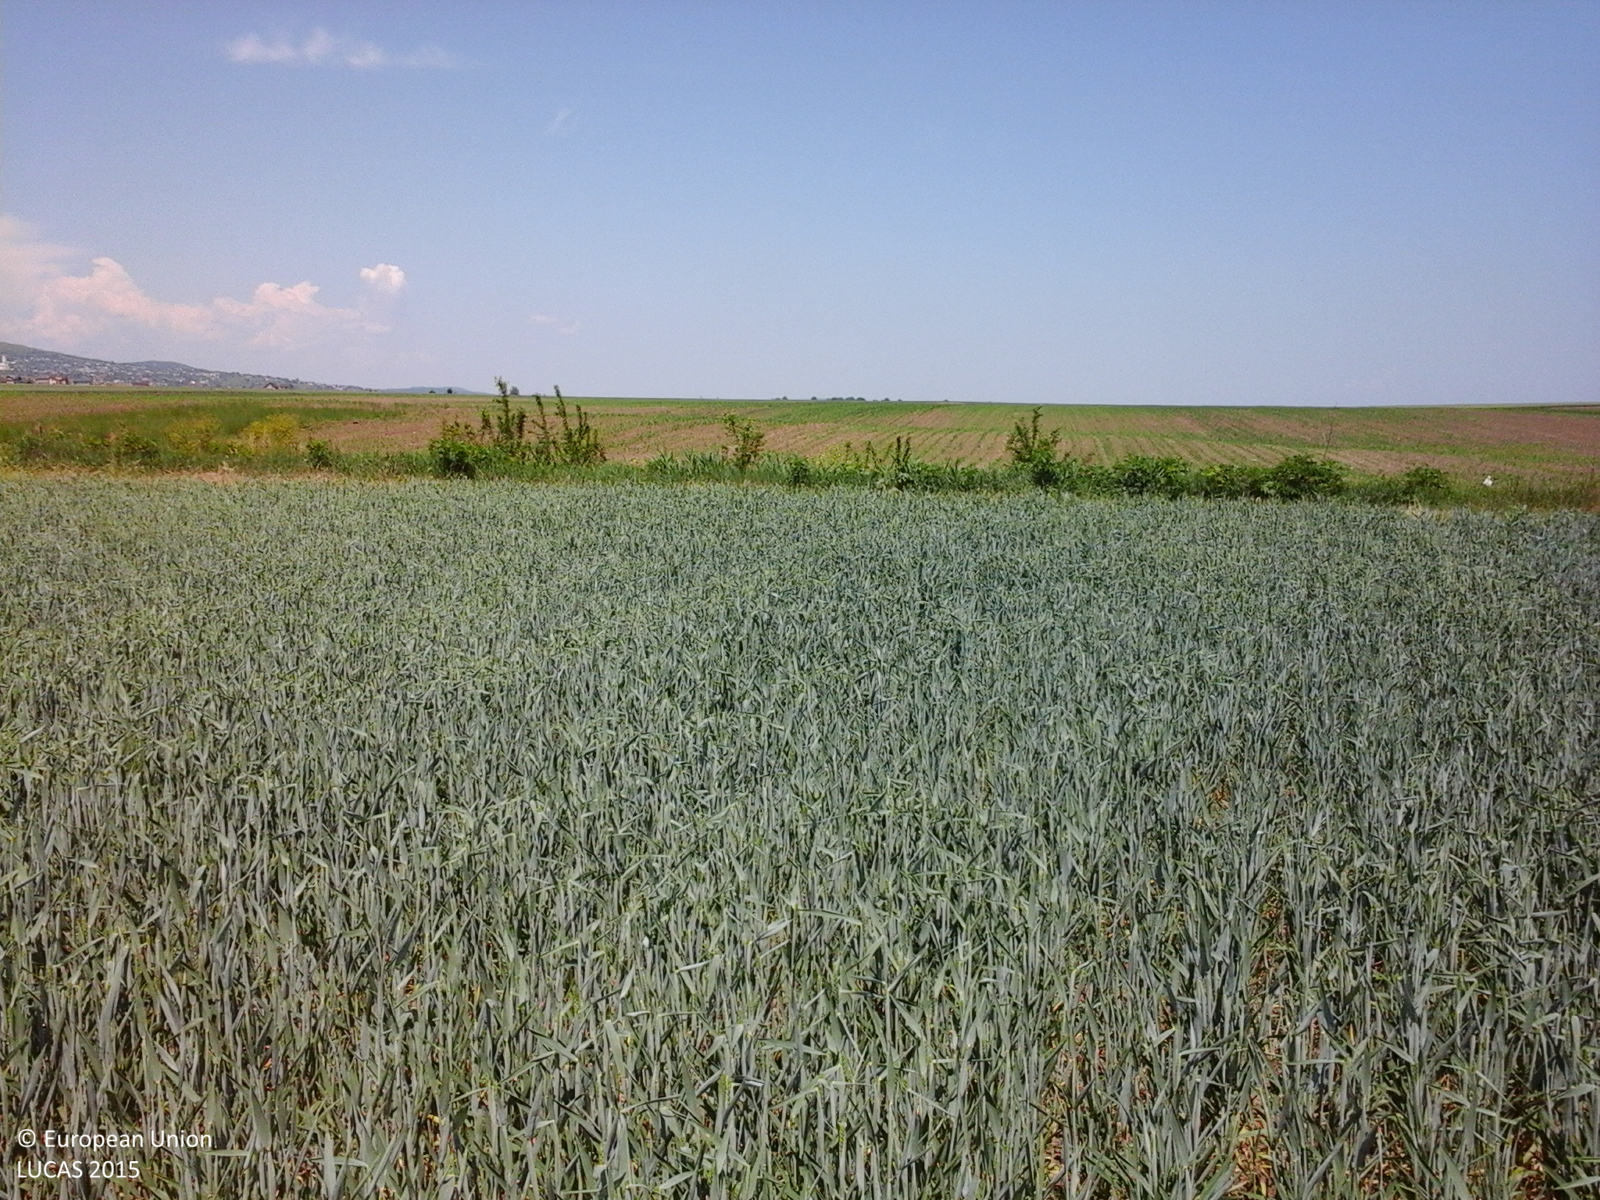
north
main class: Cropland
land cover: Common wheat
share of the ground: > 75 %
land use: Agriculture (excluding fallow land and kitchen gardens)
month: June
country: RO
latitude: 46.5032
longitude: 26.8898
